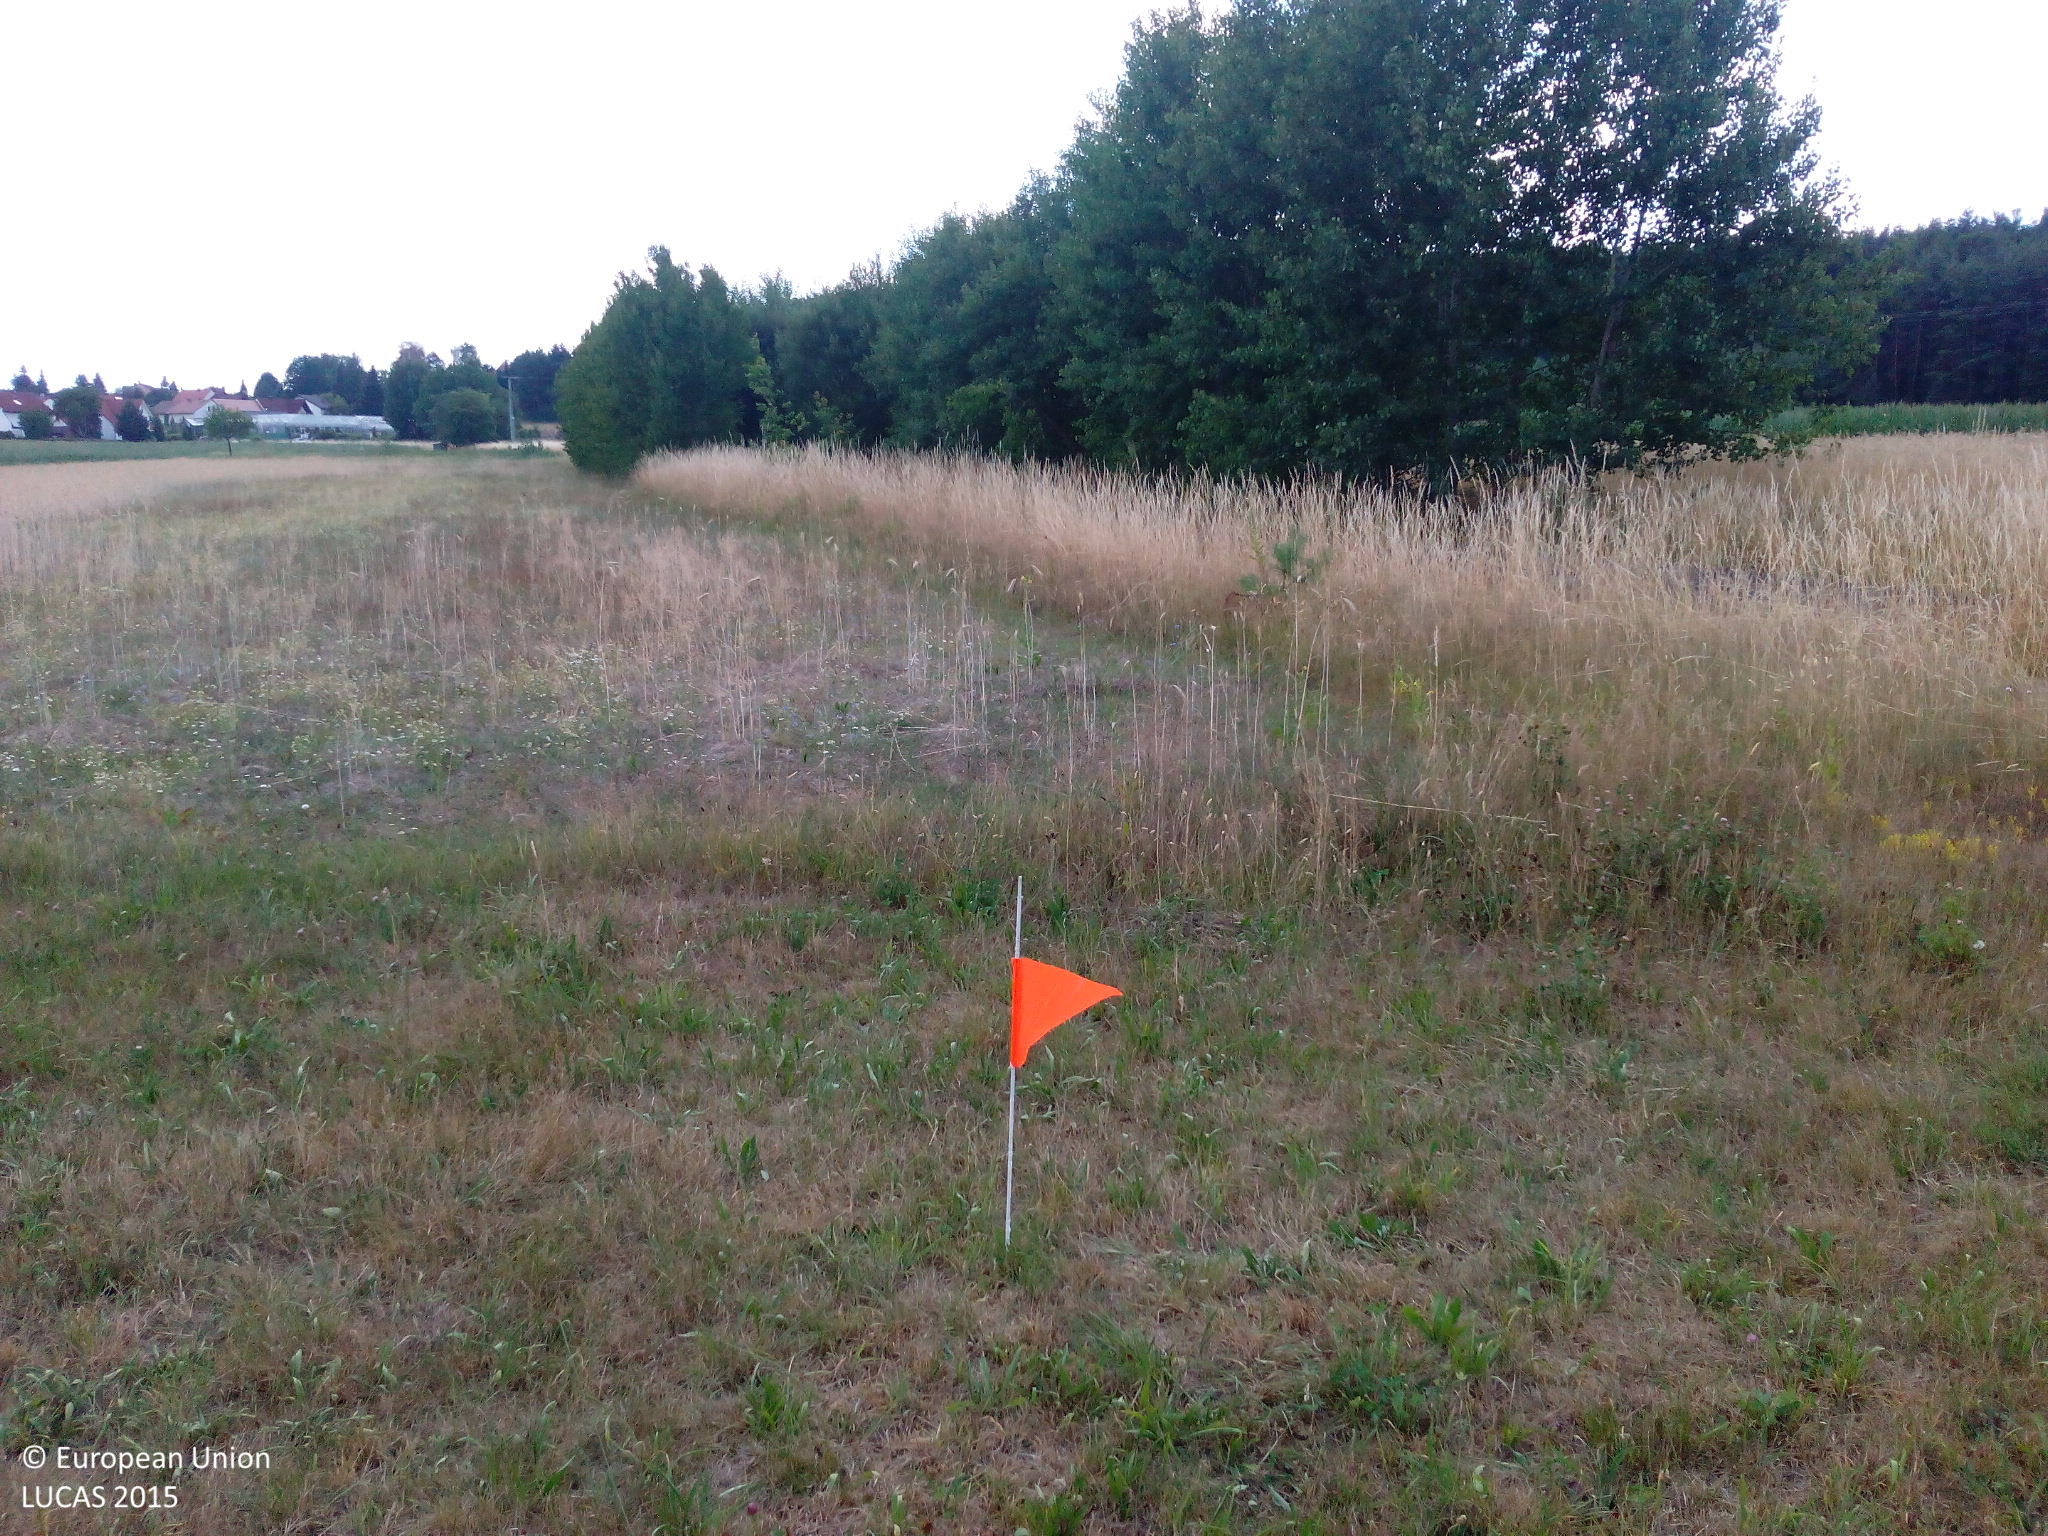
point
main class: Grassland
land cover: Grassland without tree/shrub cover
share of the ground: > 75 %
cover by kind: herbaceous plants 100 %
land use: Agriculture (excluding fallow land and kitchen gardens)
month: July
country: DE
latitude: 49.6949
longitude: 10.9285
